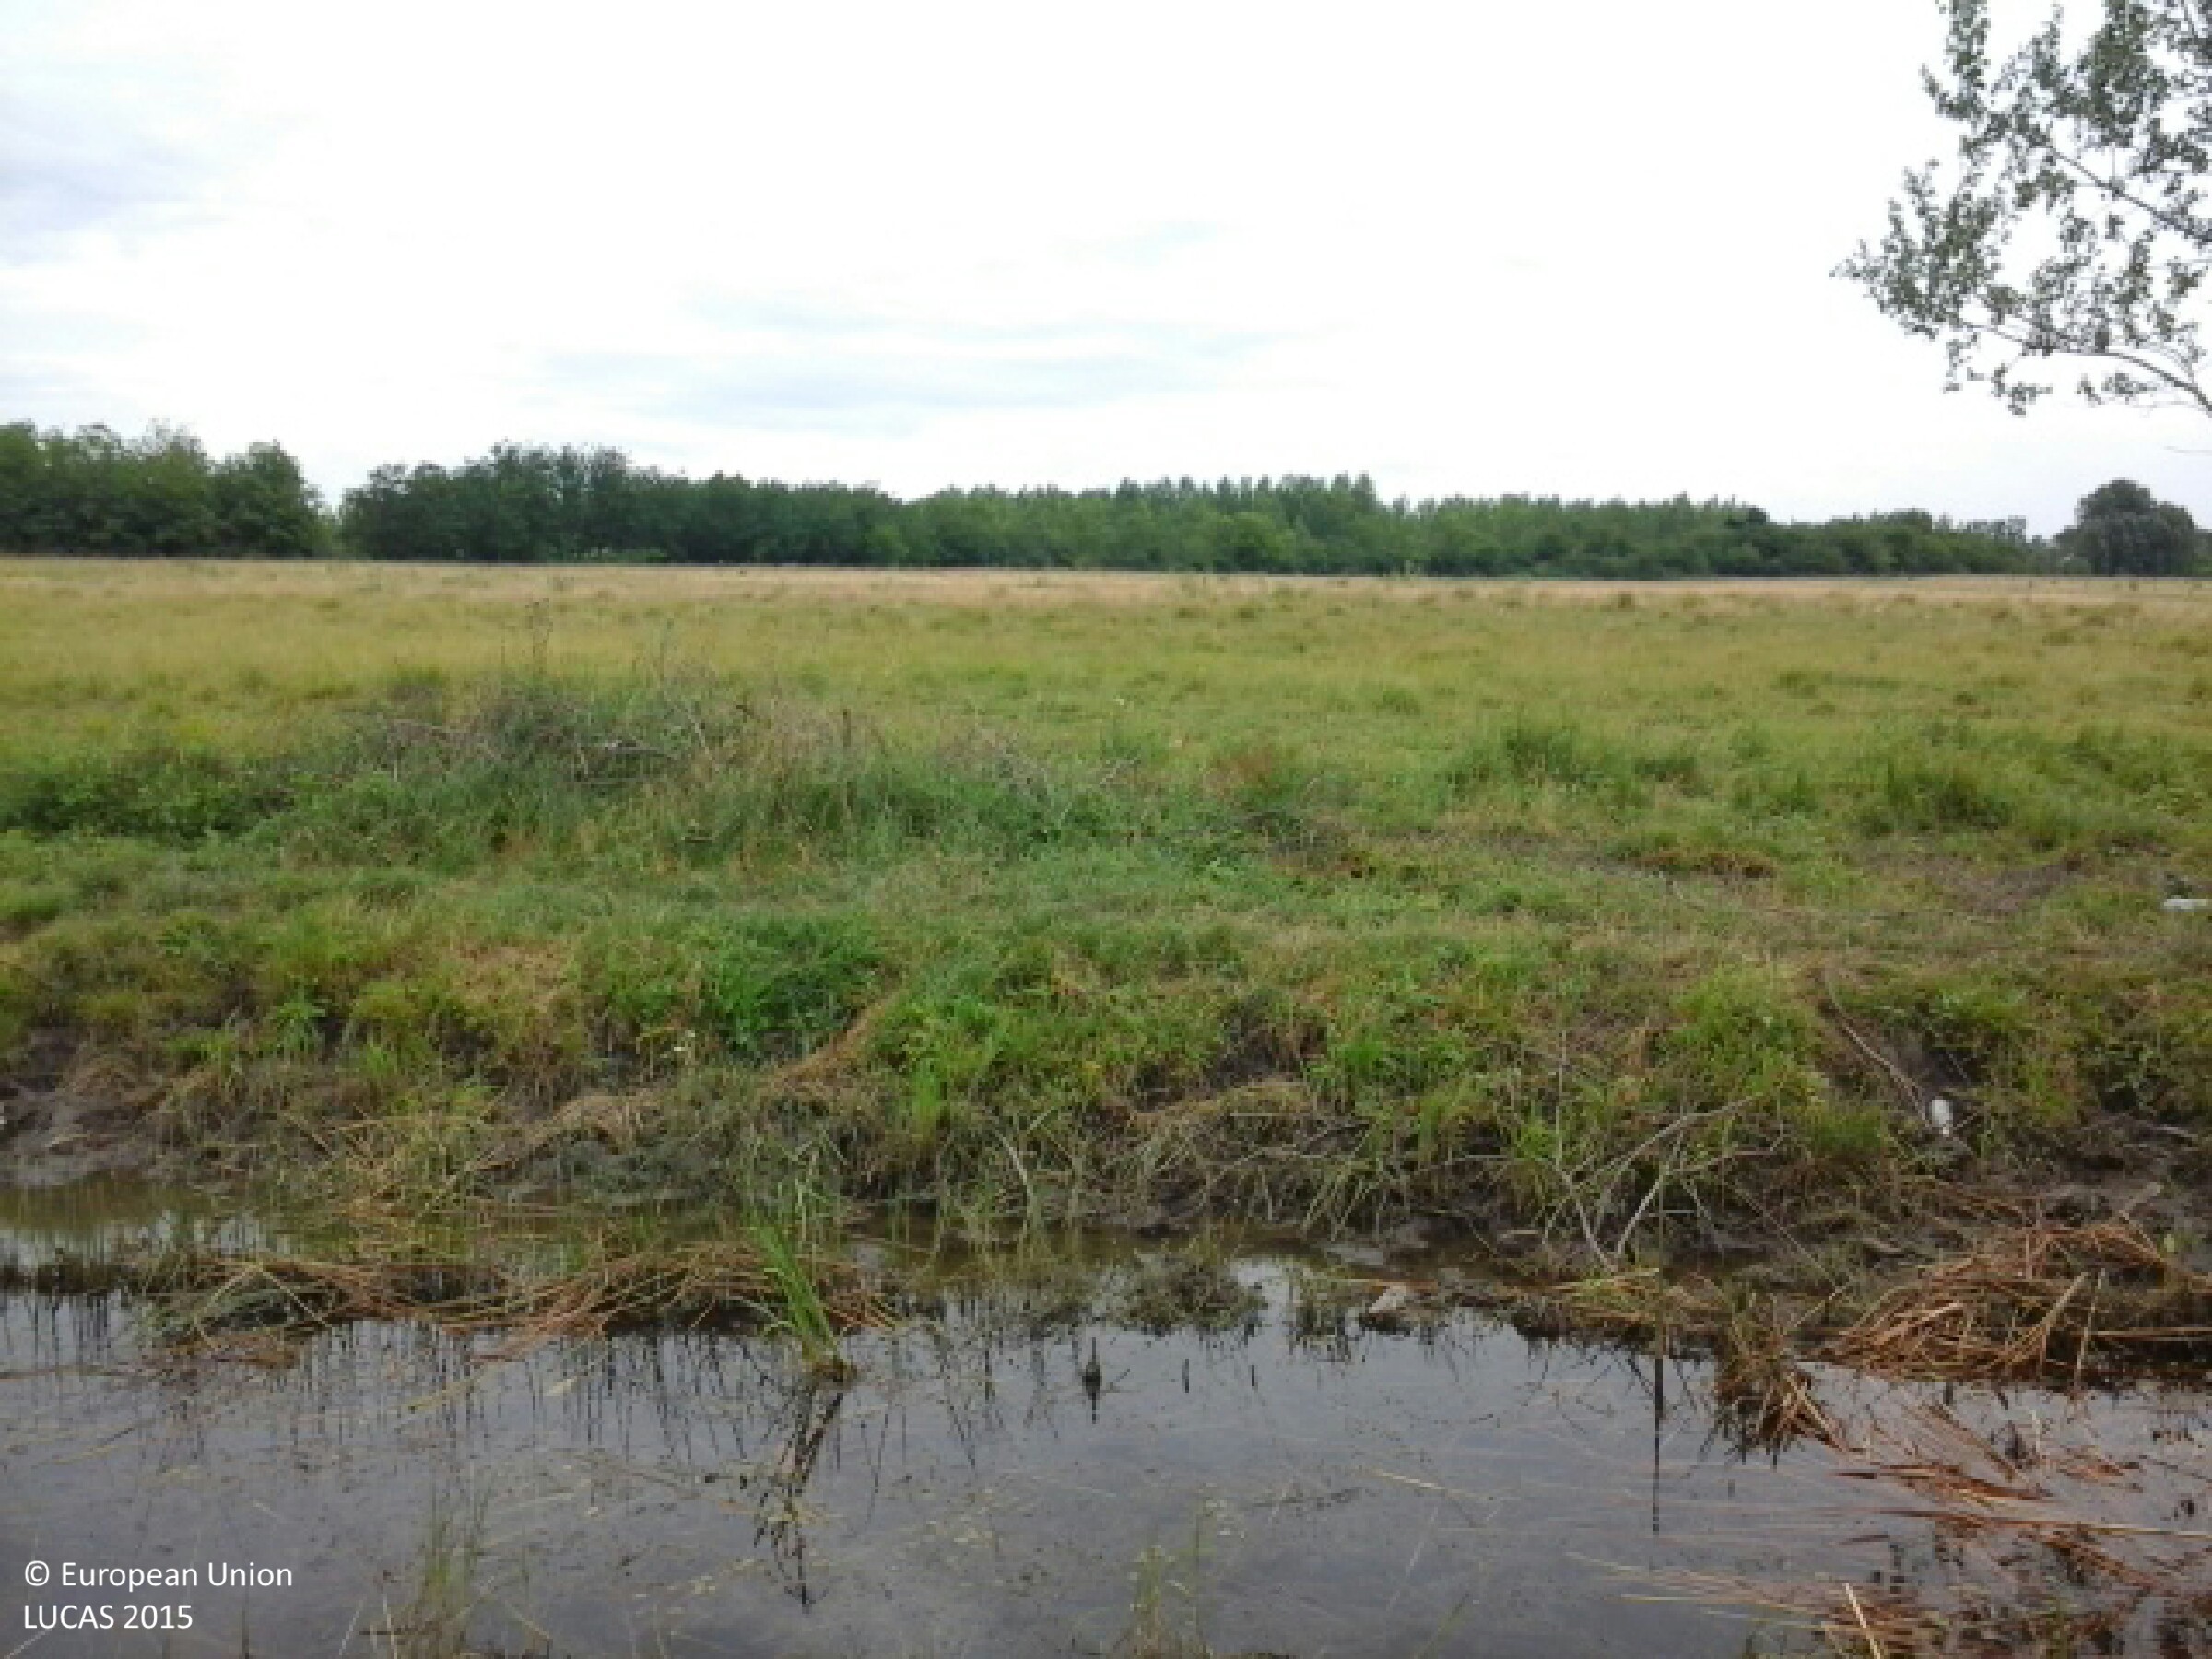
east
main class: Grassland
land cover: Grassland without tree/shrub cover
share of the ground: > 75 %
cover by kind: herbaceous plants 100 %
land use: Agriculture (excluding fallow land and kitchen gardens)
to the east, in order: Grassland without tree/shrub cover; Inland fresh running water; Grassland without tree/shrub cover; Ditches and canals; Shrubland with sparse tree cover; Grassland without tree/shrub cover
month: June
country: HU
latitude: 48.0595
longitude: 21.4636
